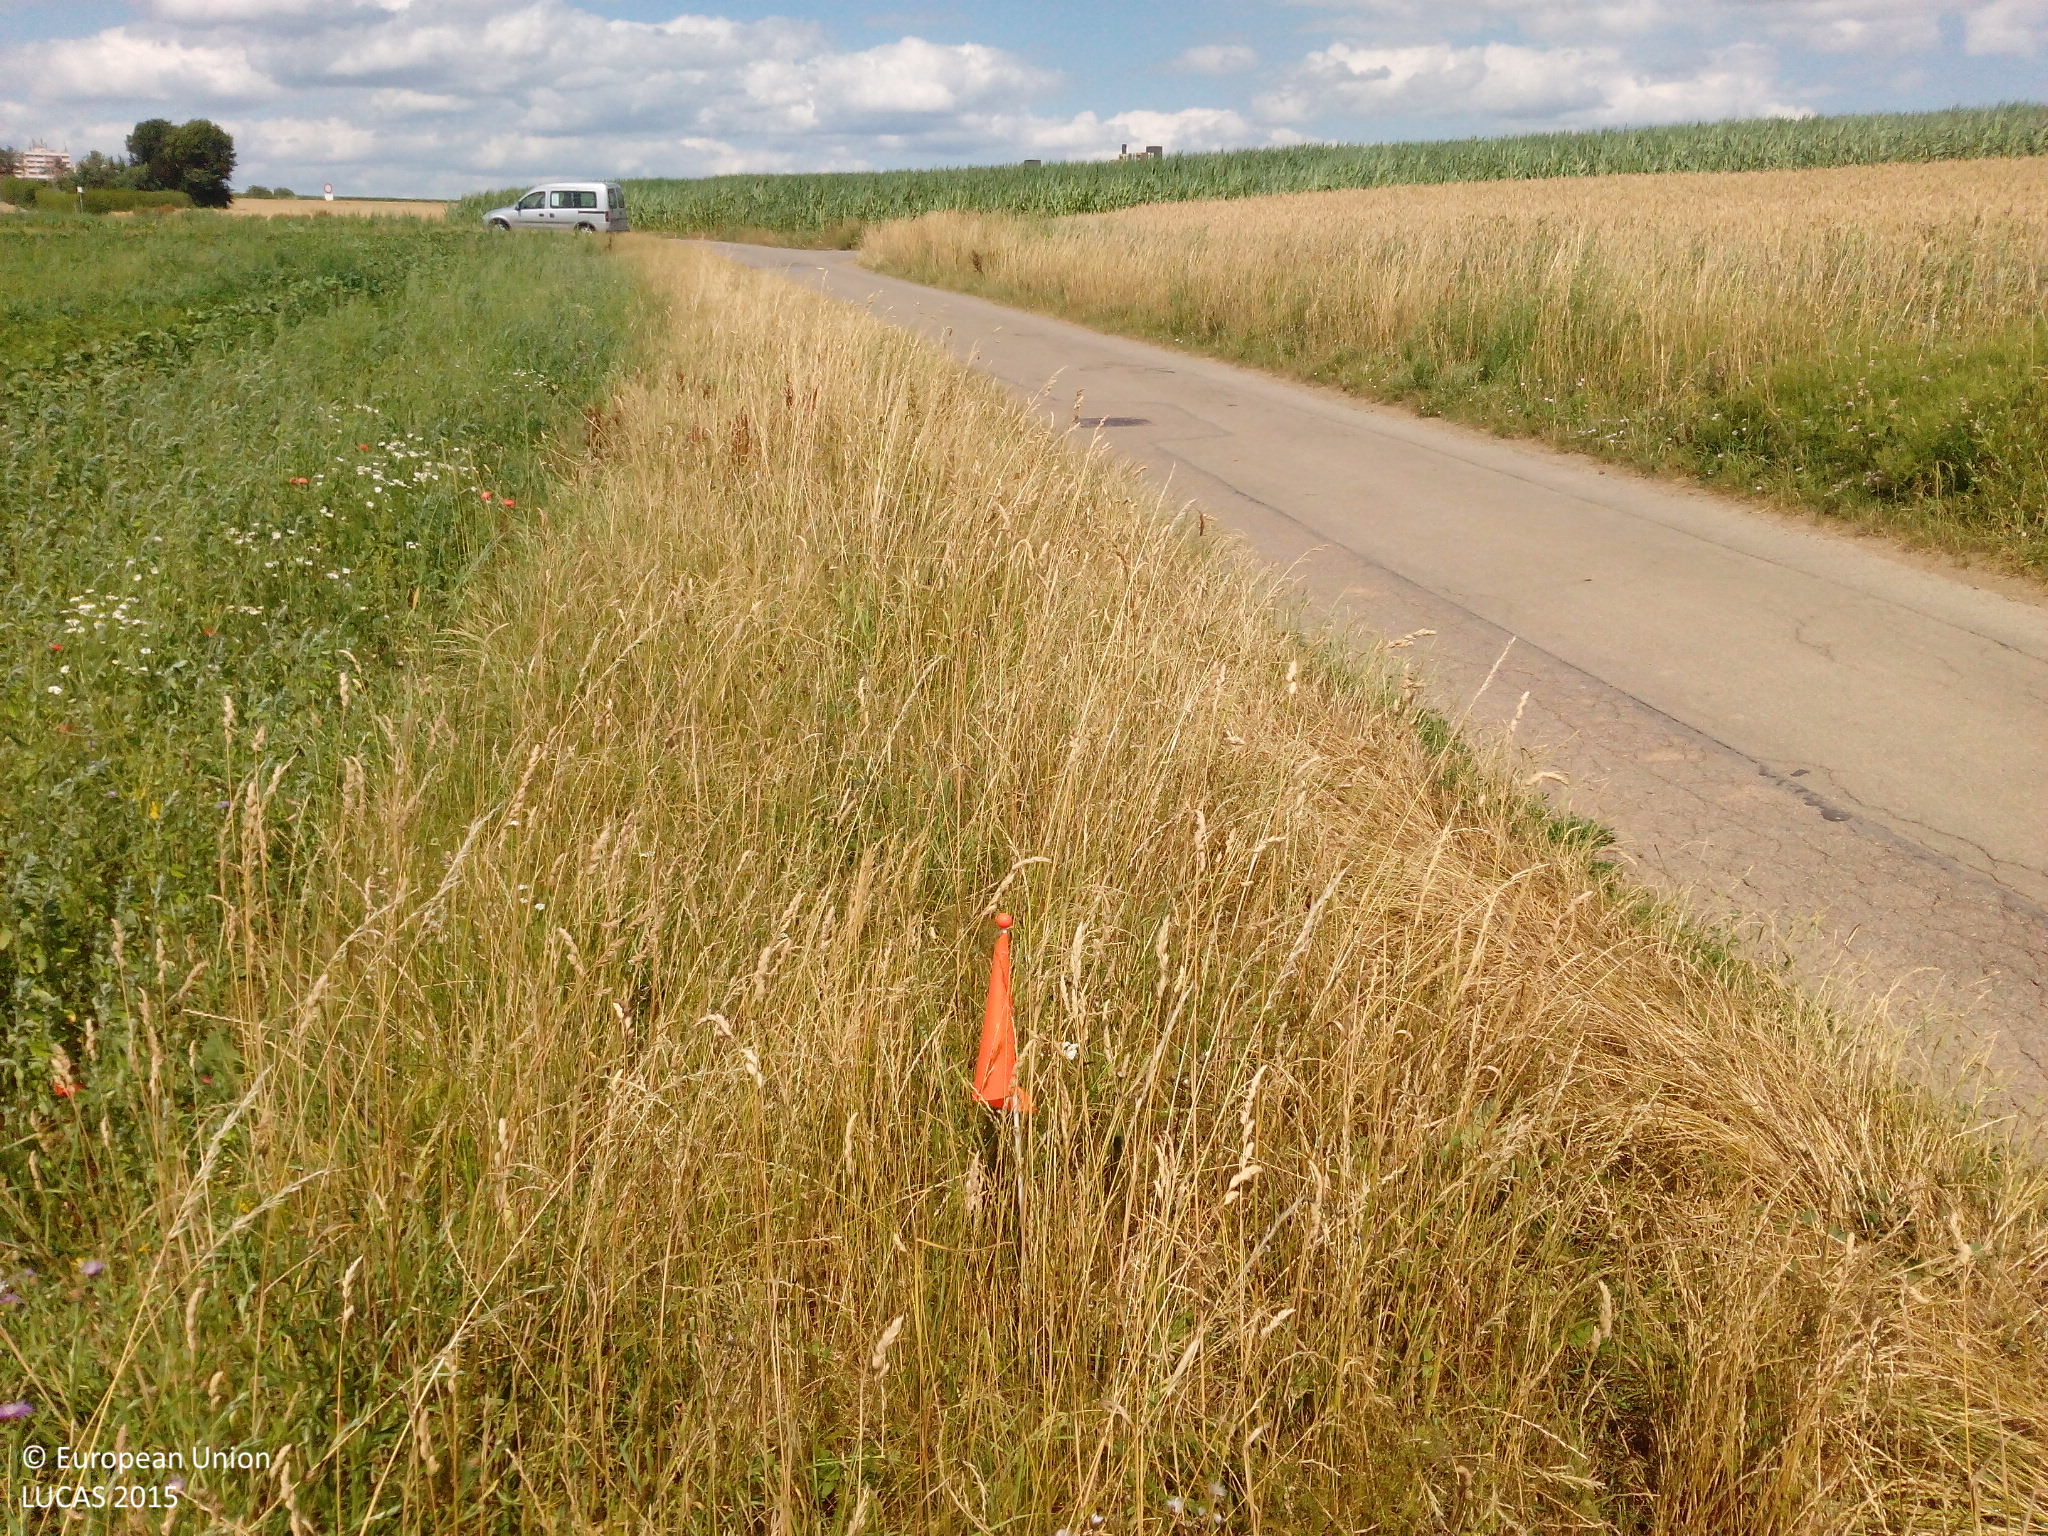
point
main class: Grassland
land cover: Spontaneously vegetated surfaces
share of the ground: > 75 %
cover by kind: herbaceous plants 85 %, unconsolidated bare surface 15 %
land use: Agriculture (excluding fallow land and kitchen gardens)
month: July
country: DE
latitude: 48.8504
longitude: 9.1963
